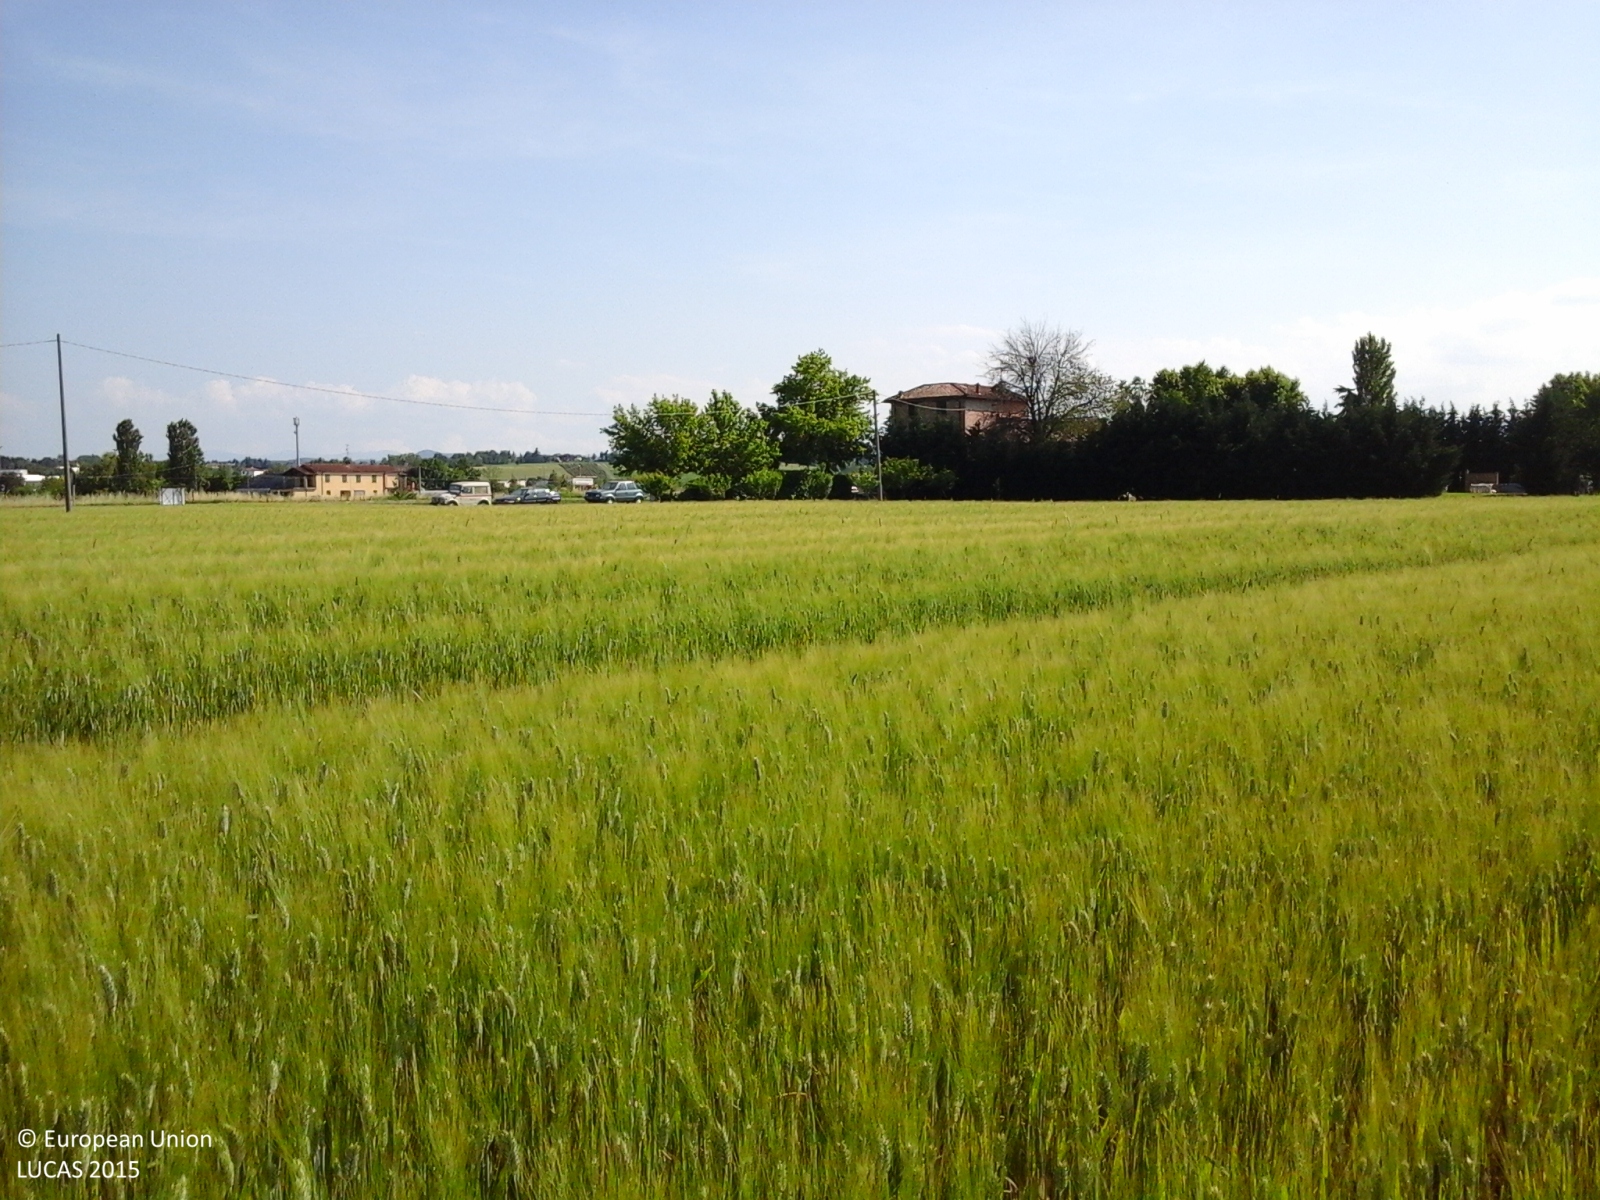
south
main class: Cropland
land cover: Durum wheat
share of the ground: > 75 %
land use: Agriculture (excluding fallow land and kitchen gardens)
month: May
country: IT
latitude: 44.8555
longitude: 10.0379
